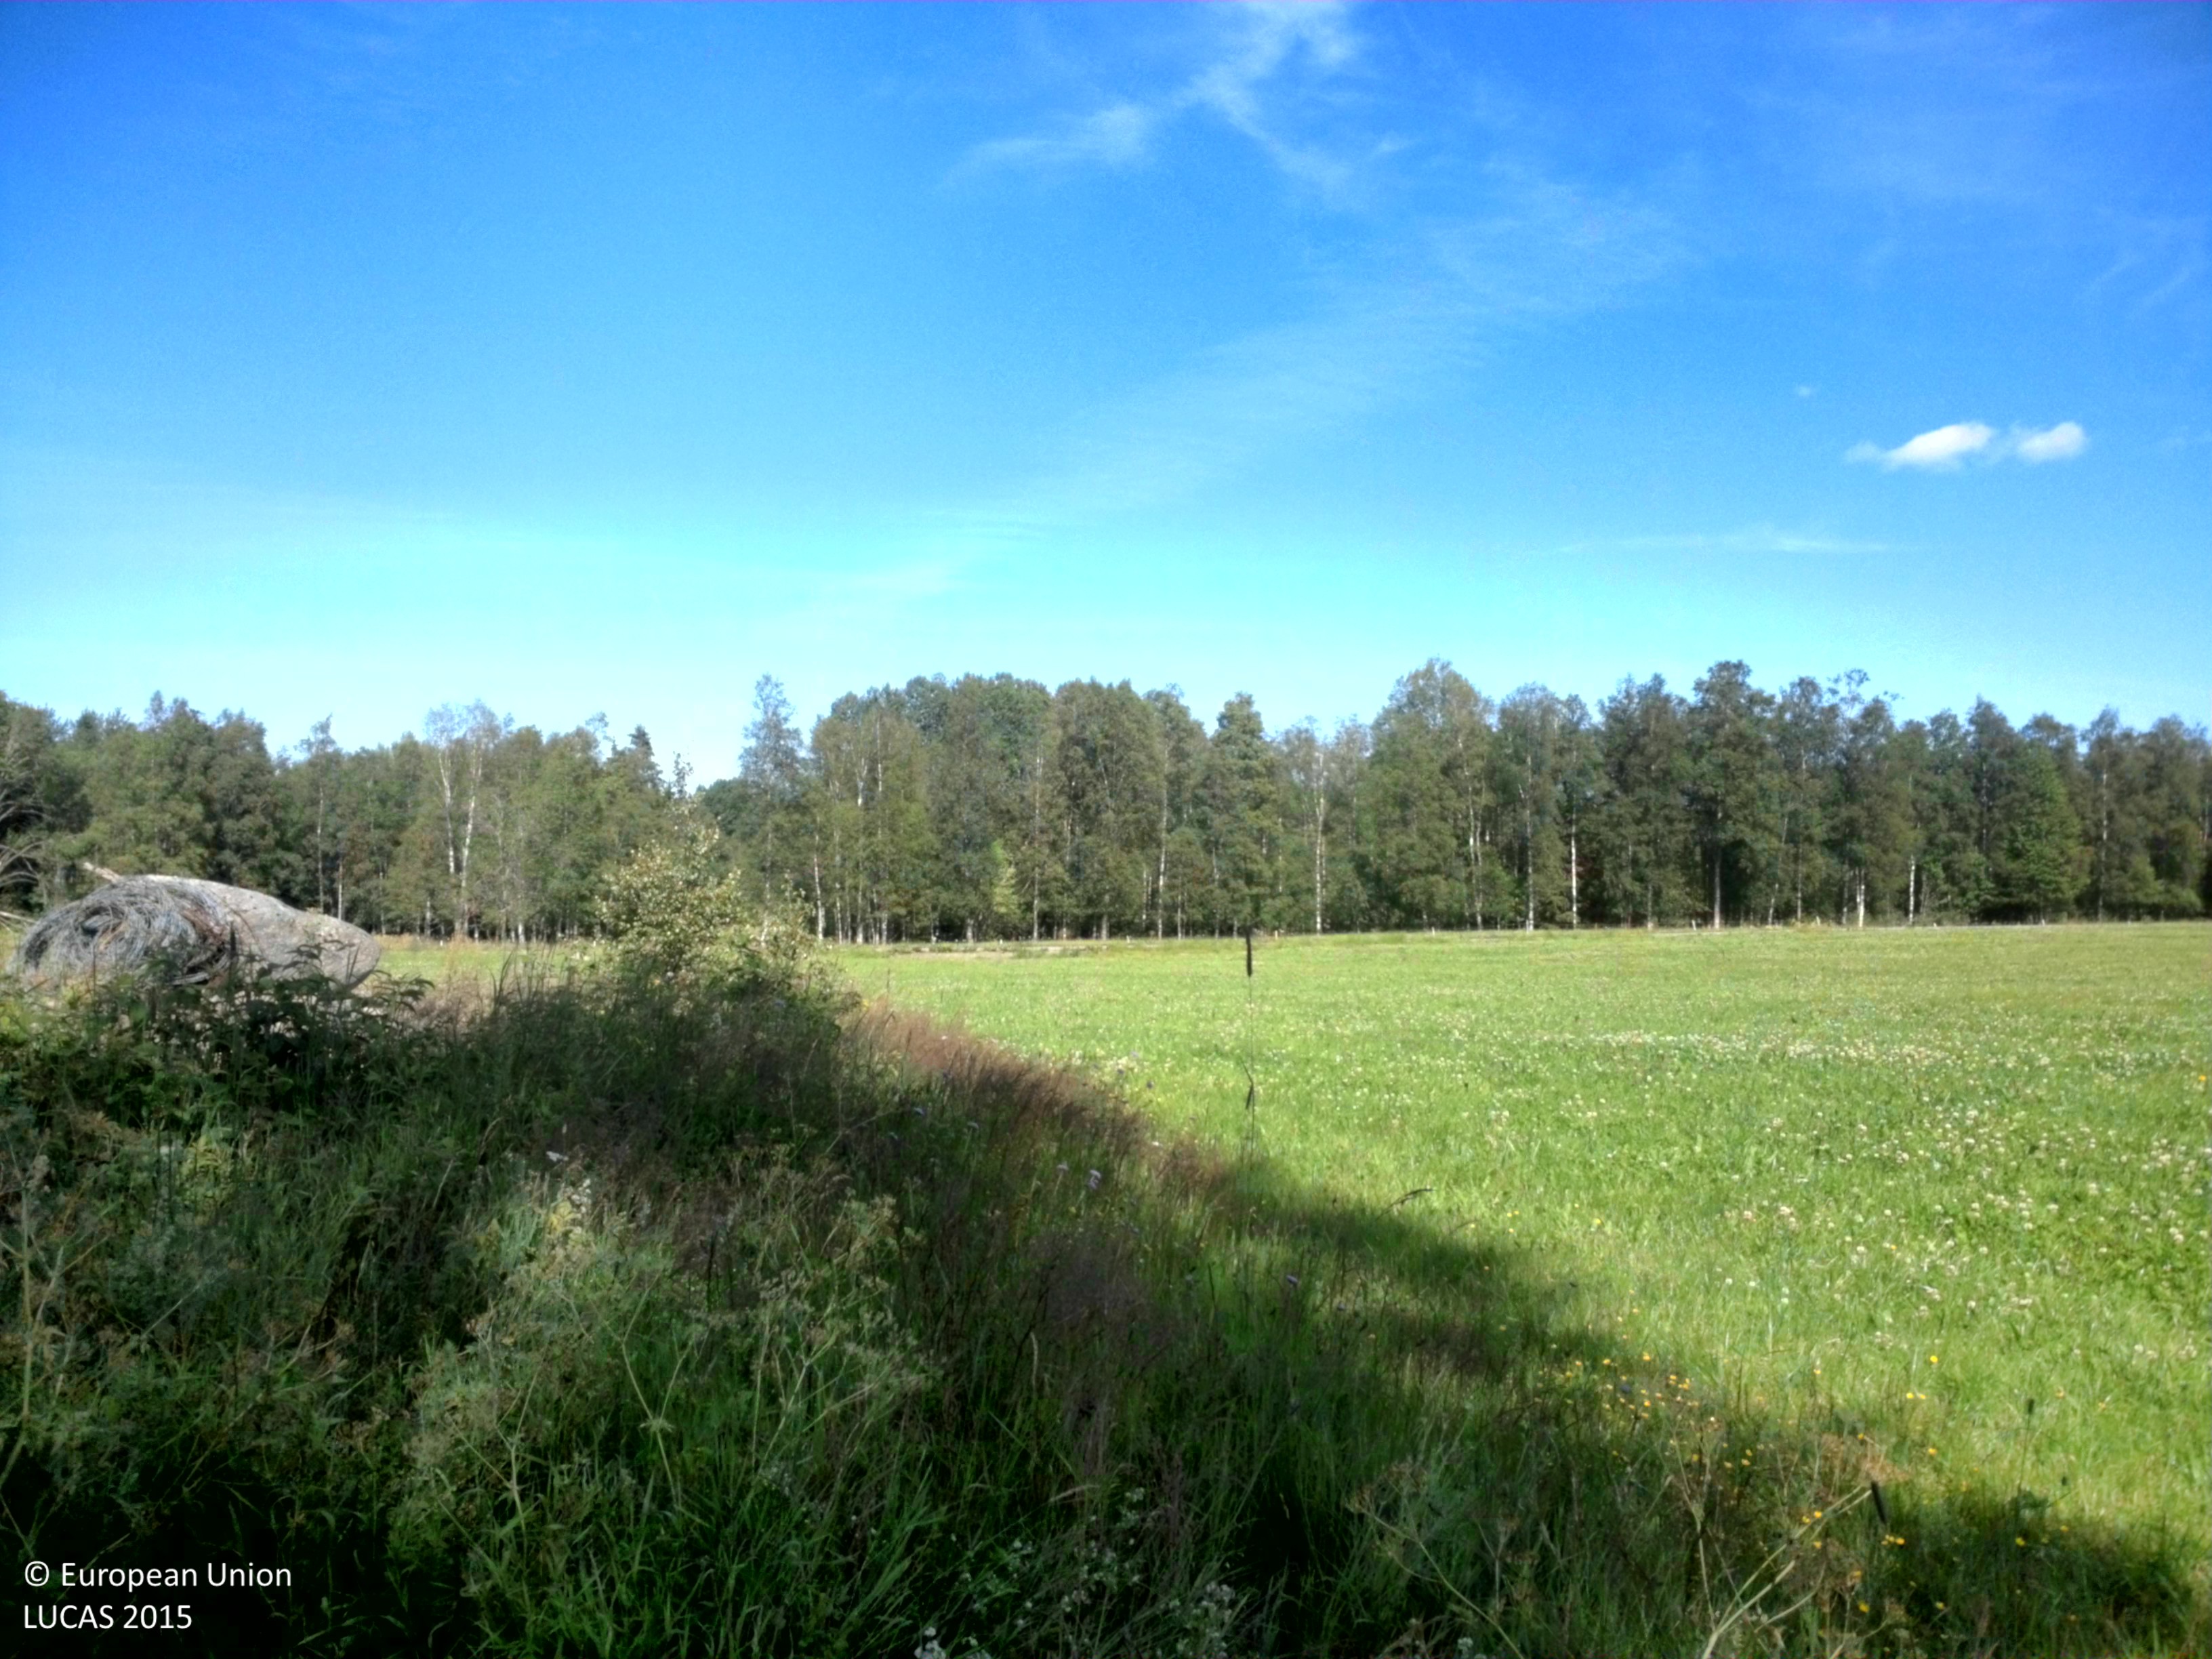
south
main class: Grassland
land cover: Grassland with sparse tree/shrub cover
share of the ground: > 75 %
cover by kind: herbaceous plants 90 %, broadleaved forest trees 5 %, shrubs 5 %
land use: Agriculture (excluding fallow land and kitchen gardens)
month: July
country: SE
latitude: 57.6274
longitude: 14.3324
